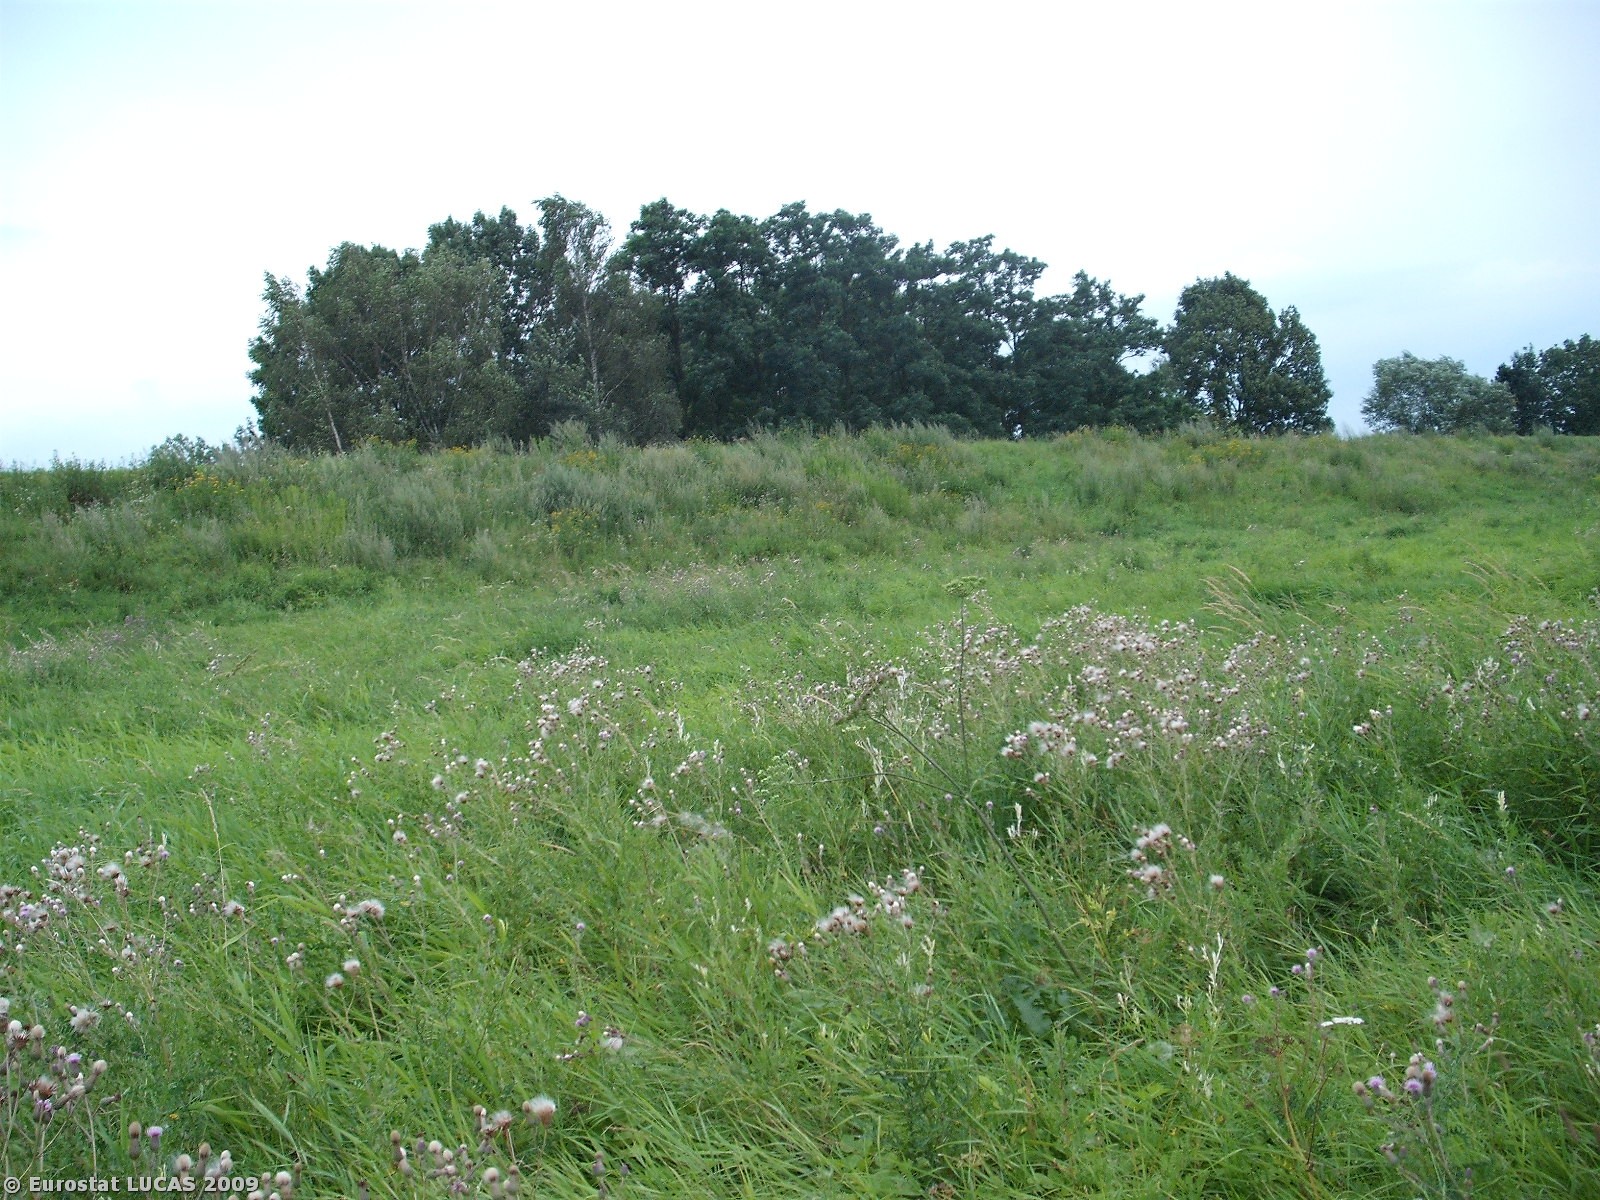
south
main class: Grassland
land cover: Grassland without tree/shrub cover
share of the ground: > 75 %
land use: Unused
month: July
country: PL
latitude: 50.0505
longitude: 20.2155
